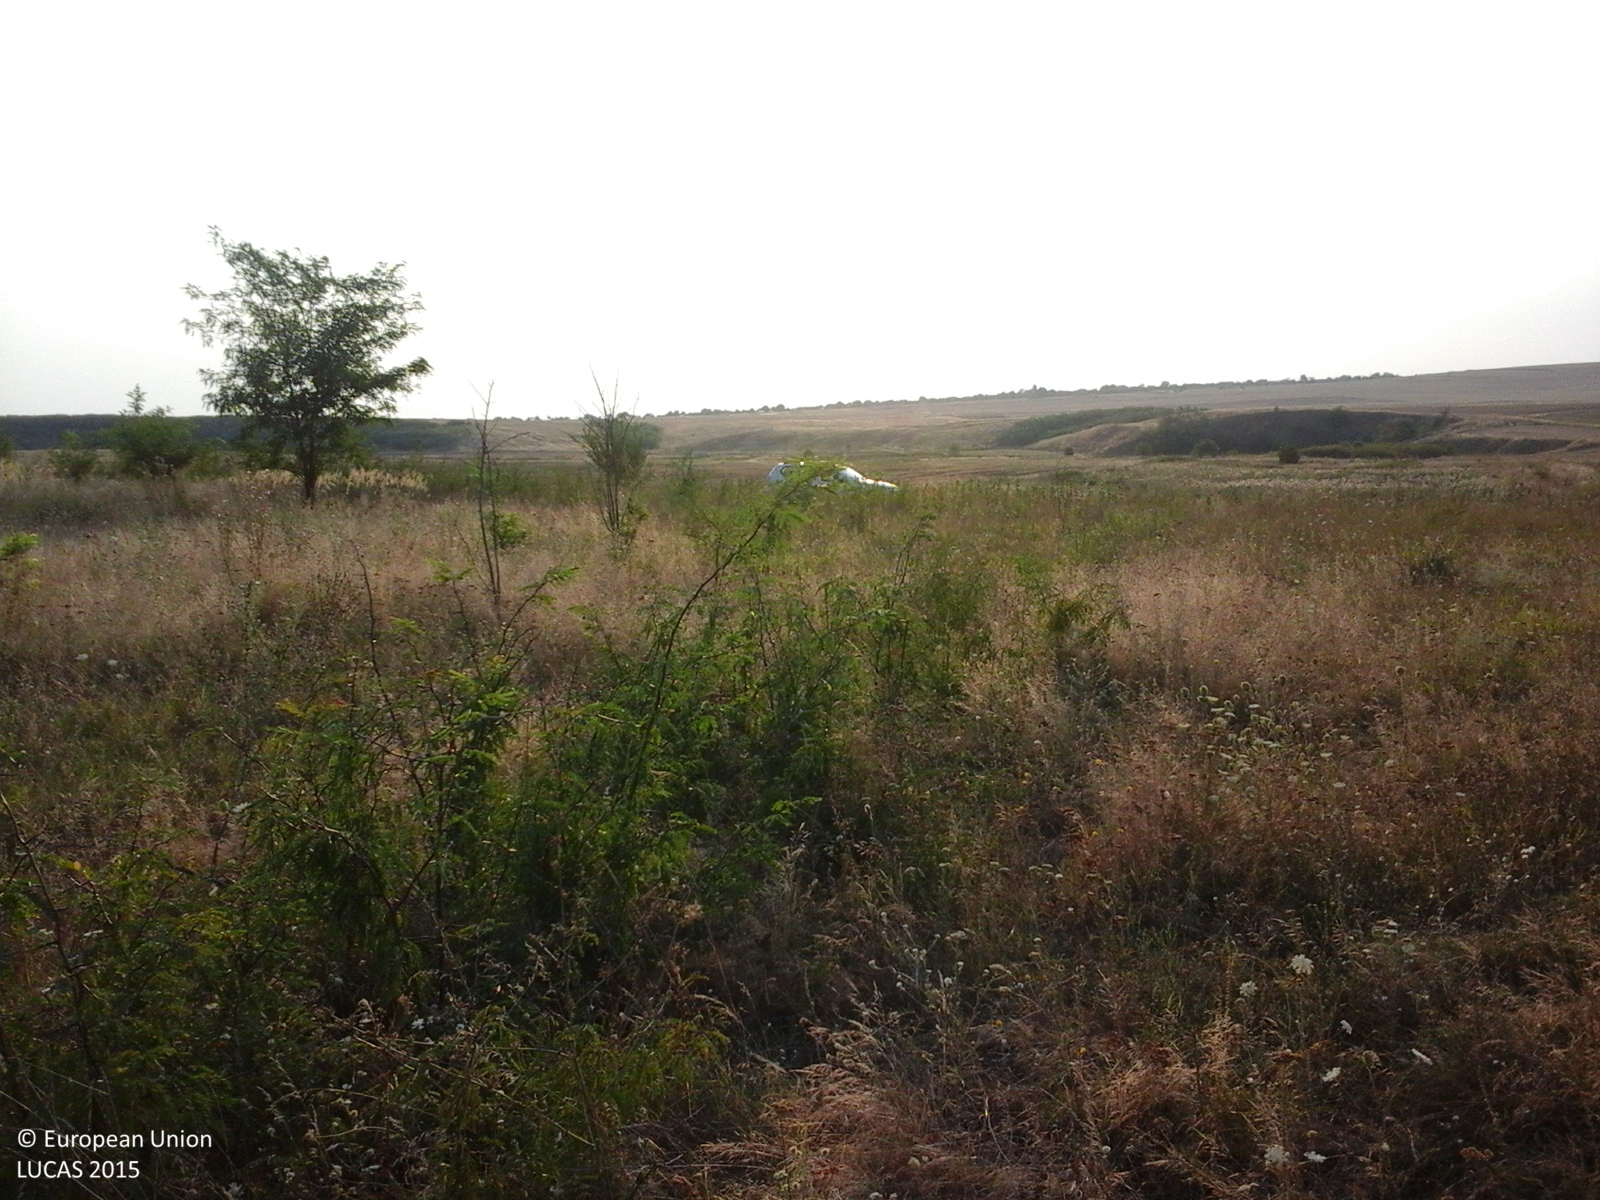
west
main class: Grassland
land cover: Grassland with sparse tree/shrub cover
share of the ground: > 75 %
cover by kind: herbaceous plants 90 %, broadleaved forest trees 5 %, shrubs 5 %
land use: Semi-natural and natural areas not in use
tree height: < 5 m
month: August
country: RO
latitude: 44.4206
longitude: 23.0196
